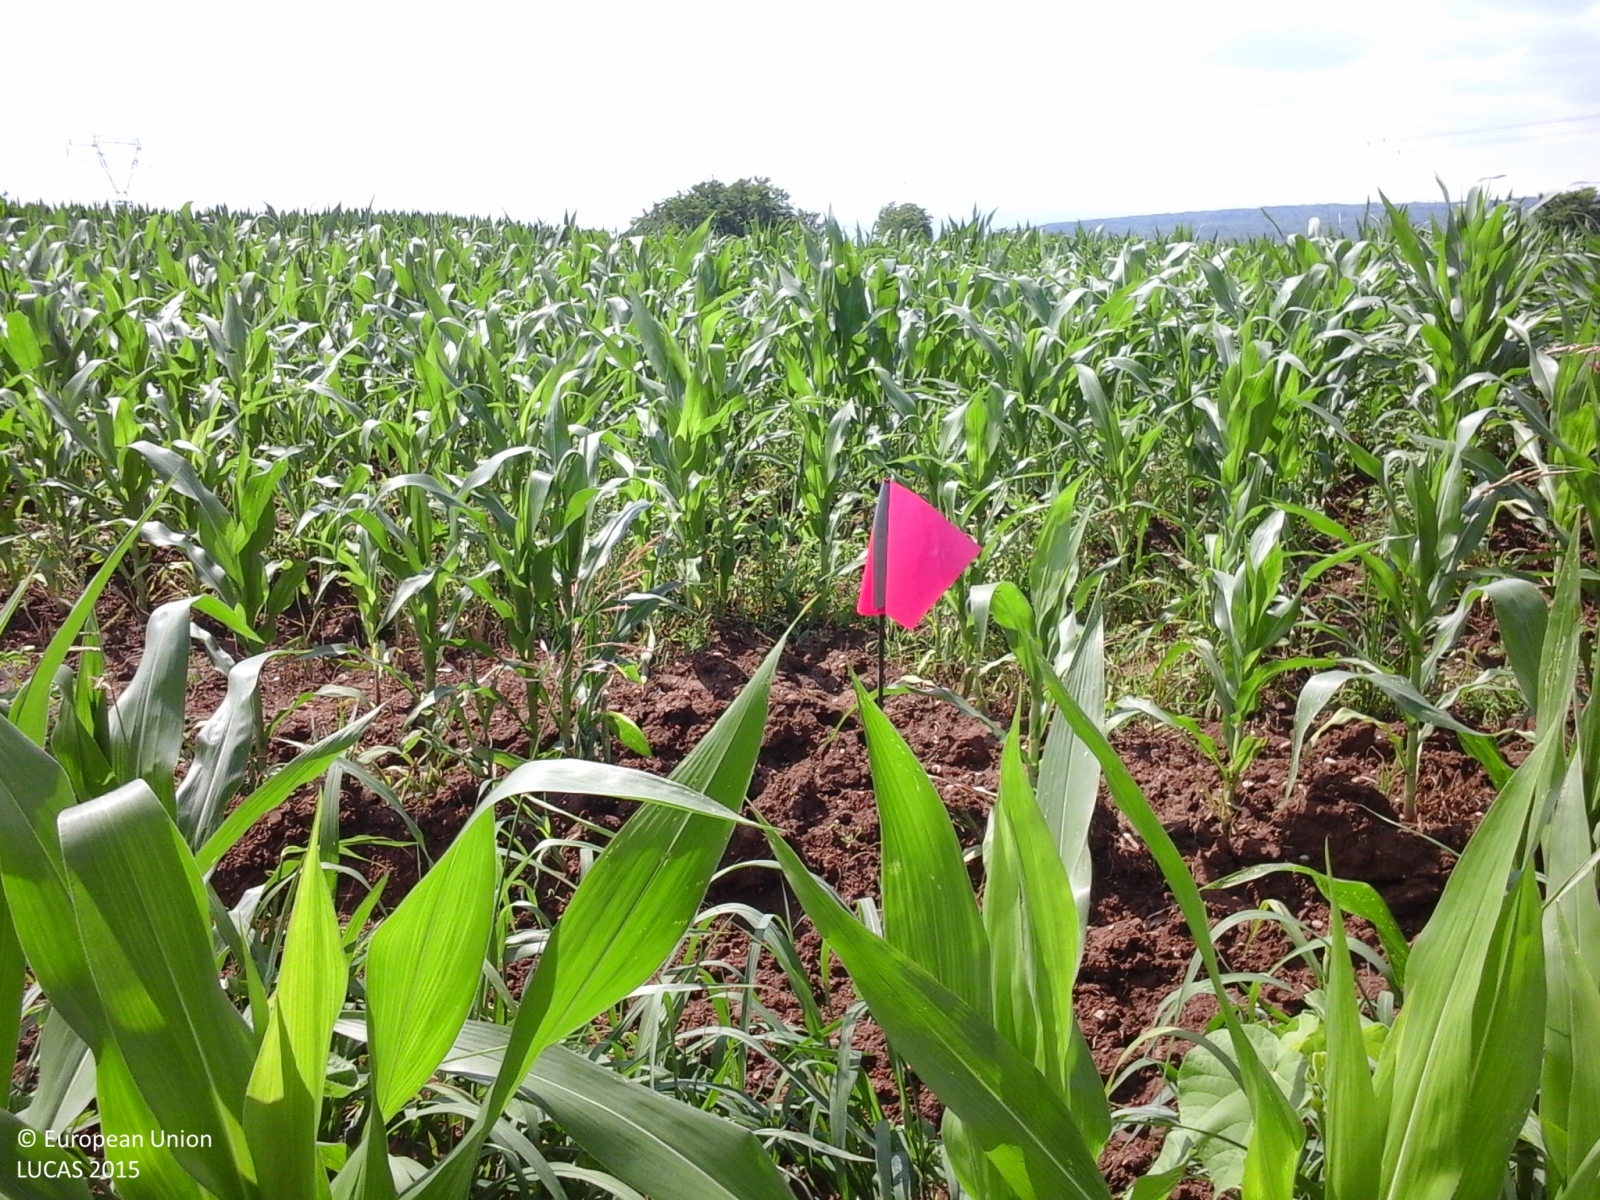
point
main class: Cropland
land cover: Maize
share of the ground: > 75 %
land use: Agriculture (excluding fallow land and kitchen gardens)
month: June
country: IT
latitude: 45.7705
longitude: 12.1701
